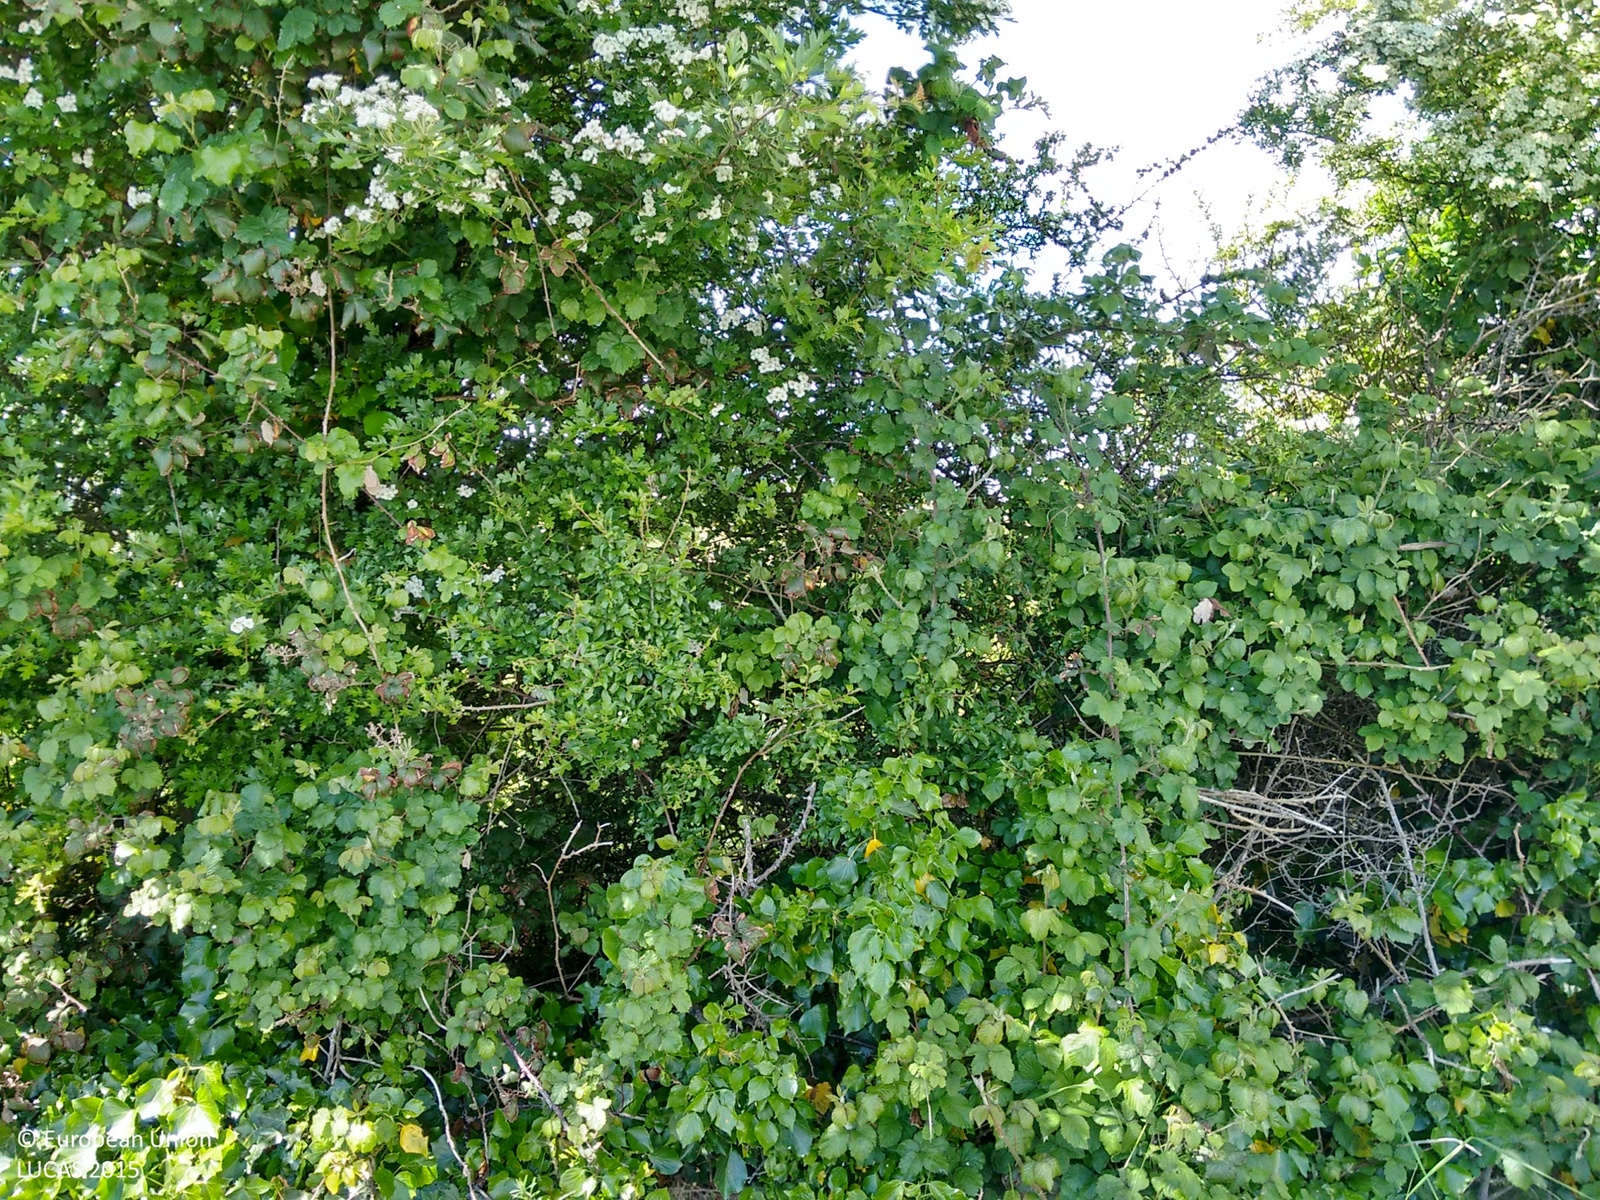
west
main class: Grassland
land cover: Grassland without tree/shrub cover
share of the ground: > 75 %
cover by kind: herbaceous plants 95 %, shrubs 5 %
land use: Agriculture (excluding fallow land and kitchen gardens)
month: May
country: IE
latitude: 53.4076
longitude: -9.0322
